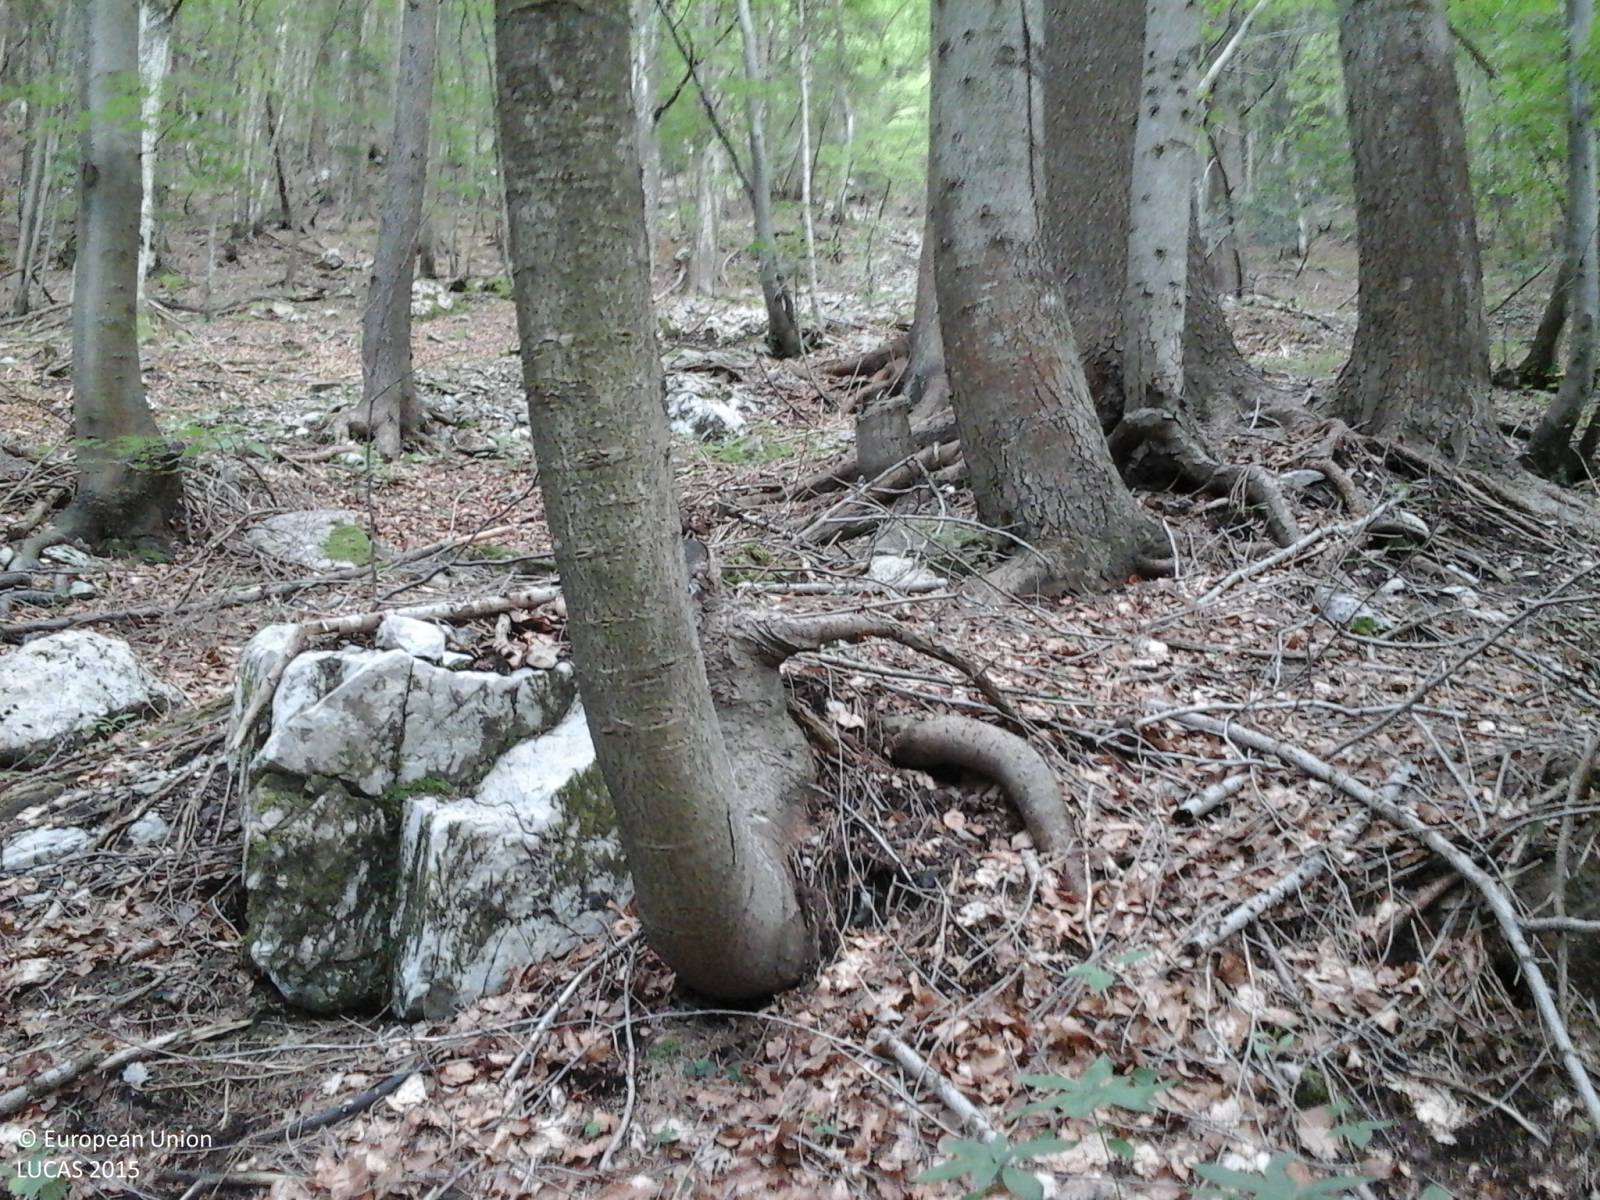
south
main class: Woodland
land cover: Other mixed woodland
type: mountainous beech forest
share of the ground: > 75 %
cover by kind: coniferous forest trees 50 %, broadleaved forest trees 50 %
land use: Forestry
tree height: > 5 m
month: June
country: IT
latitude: 46.5004
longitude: 13.2416
